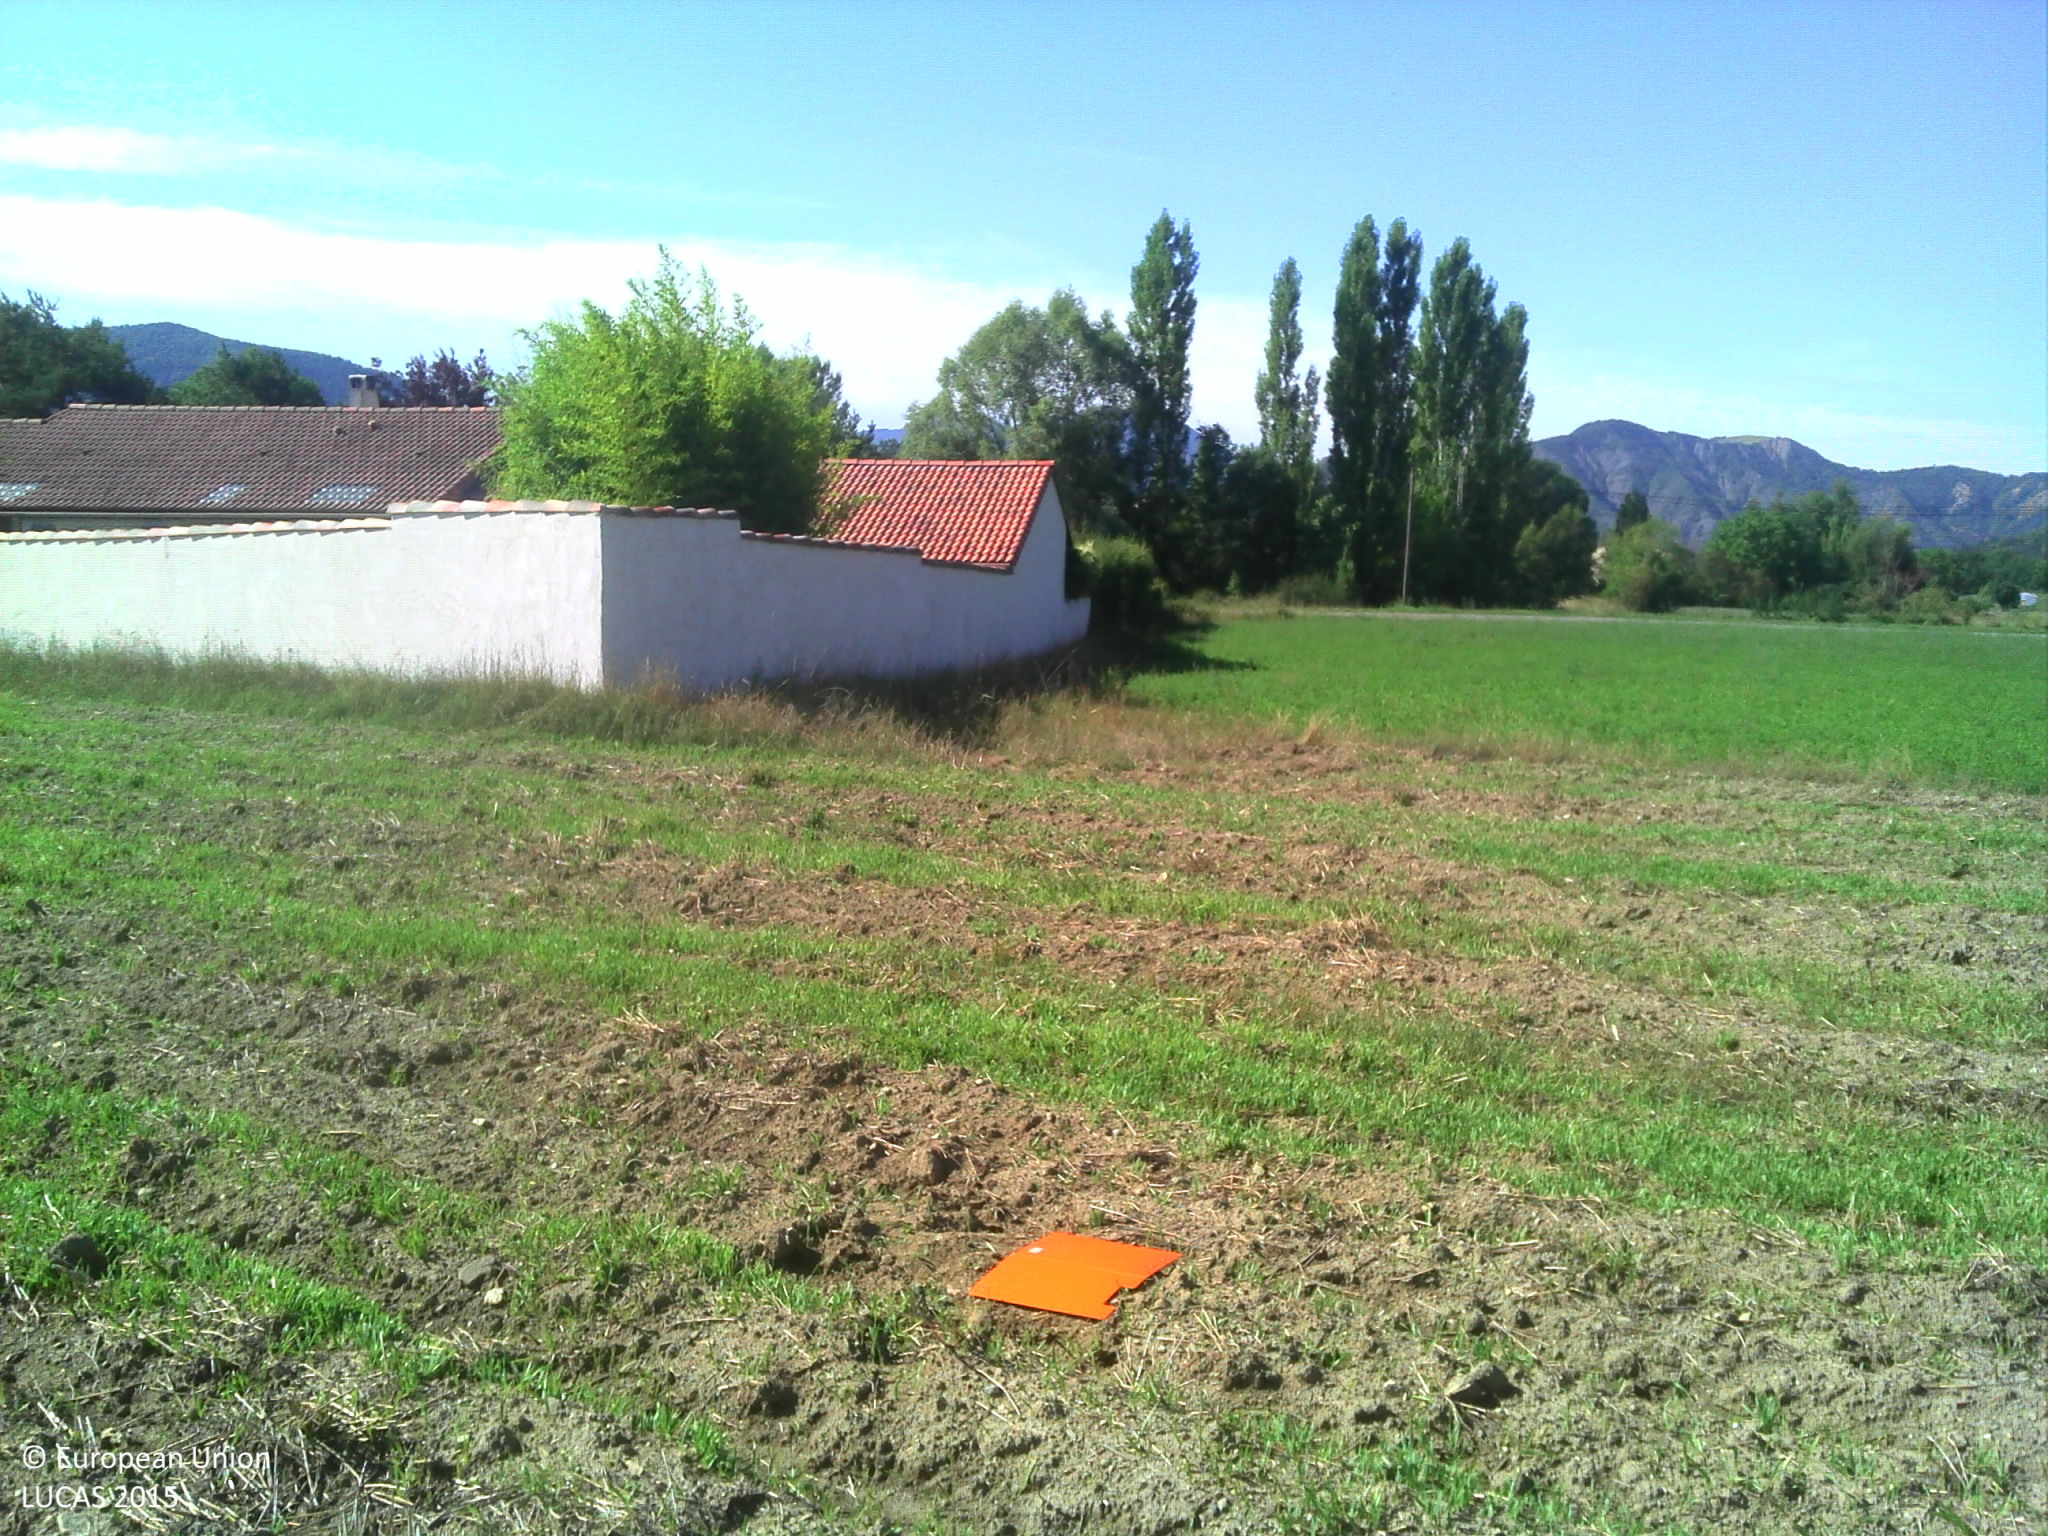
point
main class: Grassland
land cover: Grassland without tree/shrub cover
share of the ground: > 75 %
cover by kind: unconsolidated bare surface 60 %, herbaceous plants 40 %
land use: Agriculture (excluding fallow land and kitchen gardens)
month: August
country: FR
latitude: 44.1580
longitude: 6.2936
